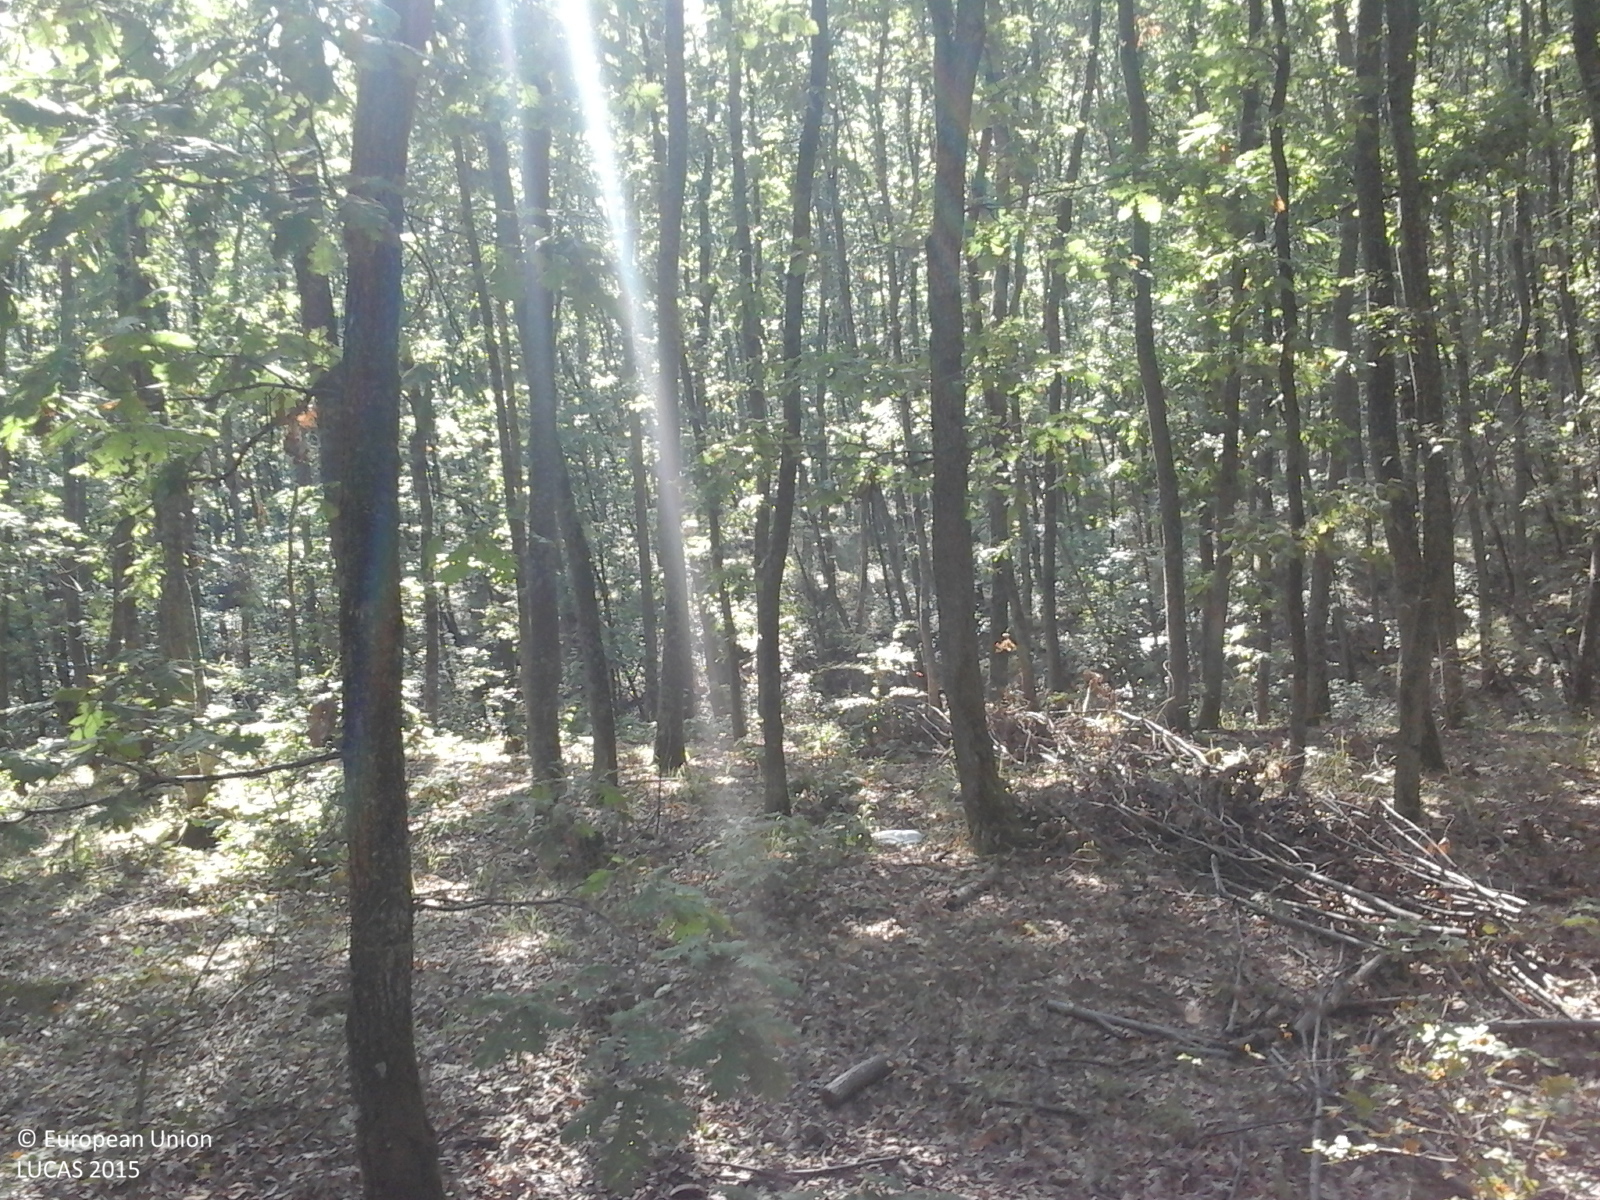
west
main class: Woodland
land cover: Broadleaved woodland
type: acidophilous oak and oak-birch forest
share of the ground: > 75 %
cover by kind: broadleaved forest trees 100 %
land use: Forestry
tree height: > 5 m
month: August
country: RO
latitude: 45.9654
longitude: 21.6638
